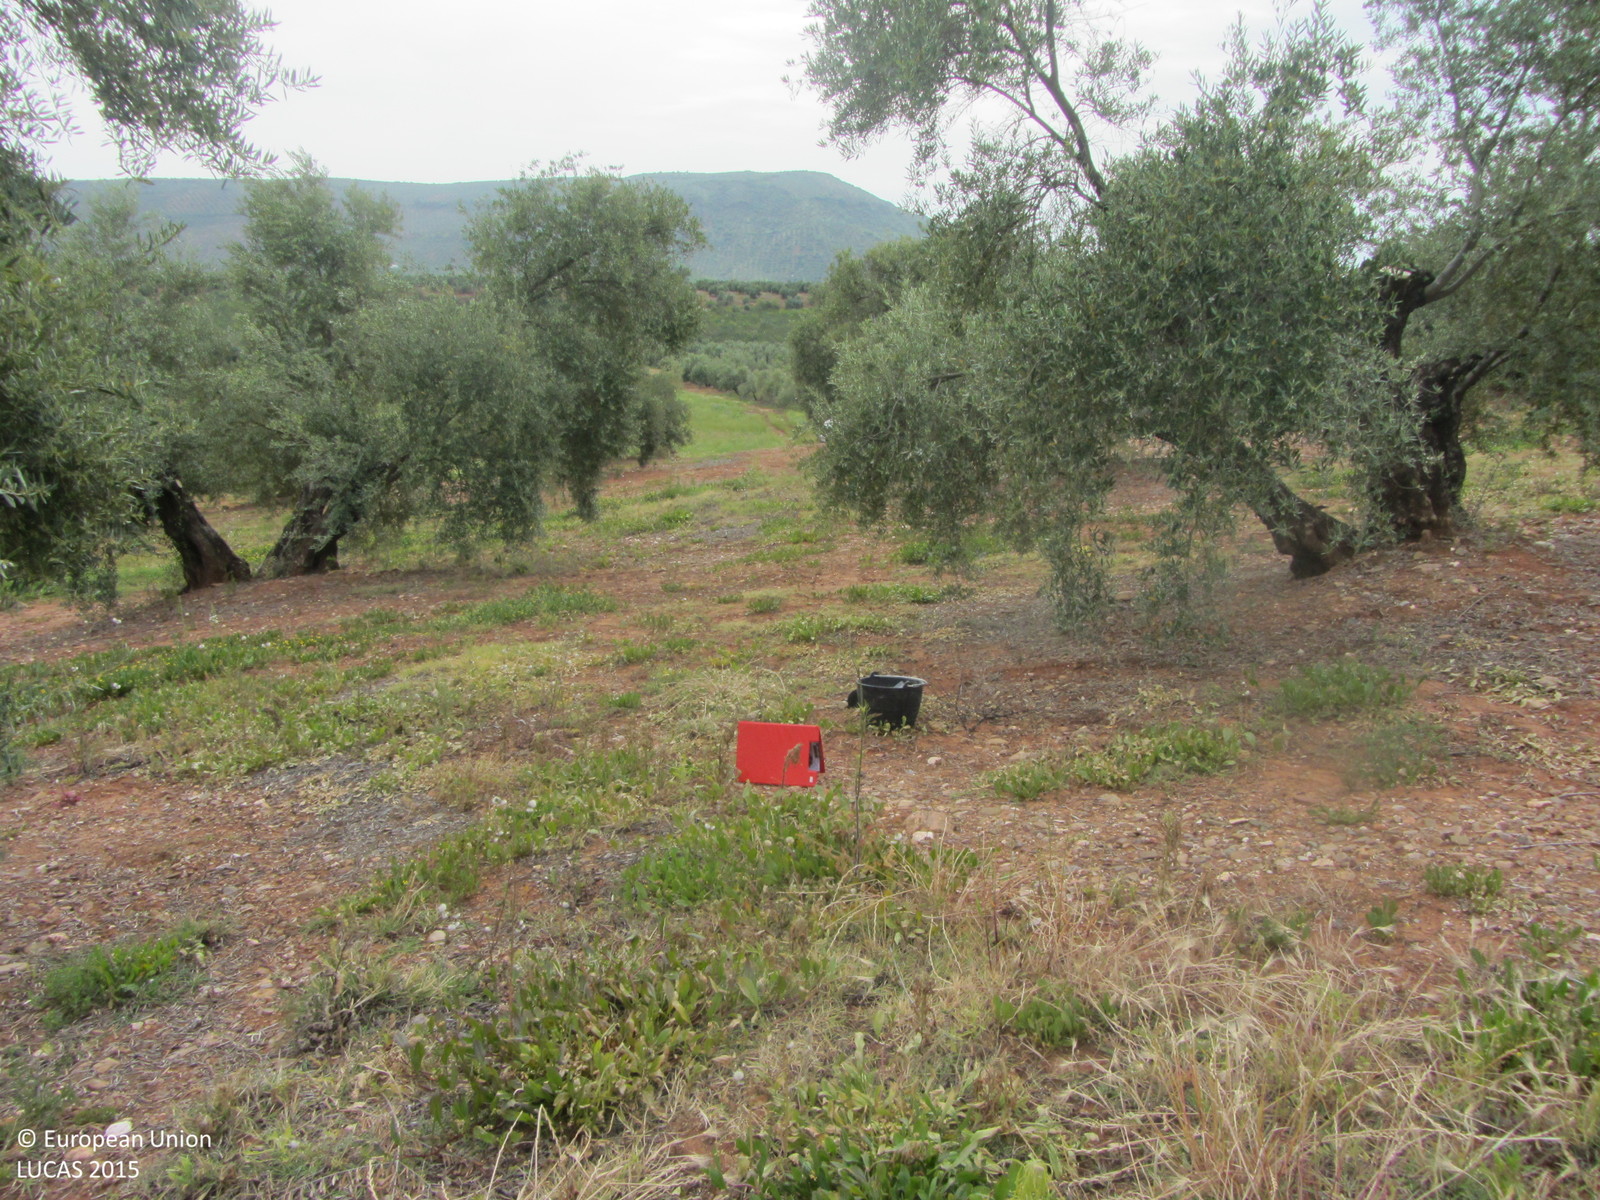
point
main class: Cropland
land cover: Olive groves
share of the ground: 25 - 50 %
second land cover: Spontaneously vegetated surfaces
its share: 50 - 75 %
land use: Agriculture (excluding fallow land and kitchen gardens)
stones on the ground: > 50 %
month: May
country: ES
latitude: 38.2636
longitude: -2.9949
